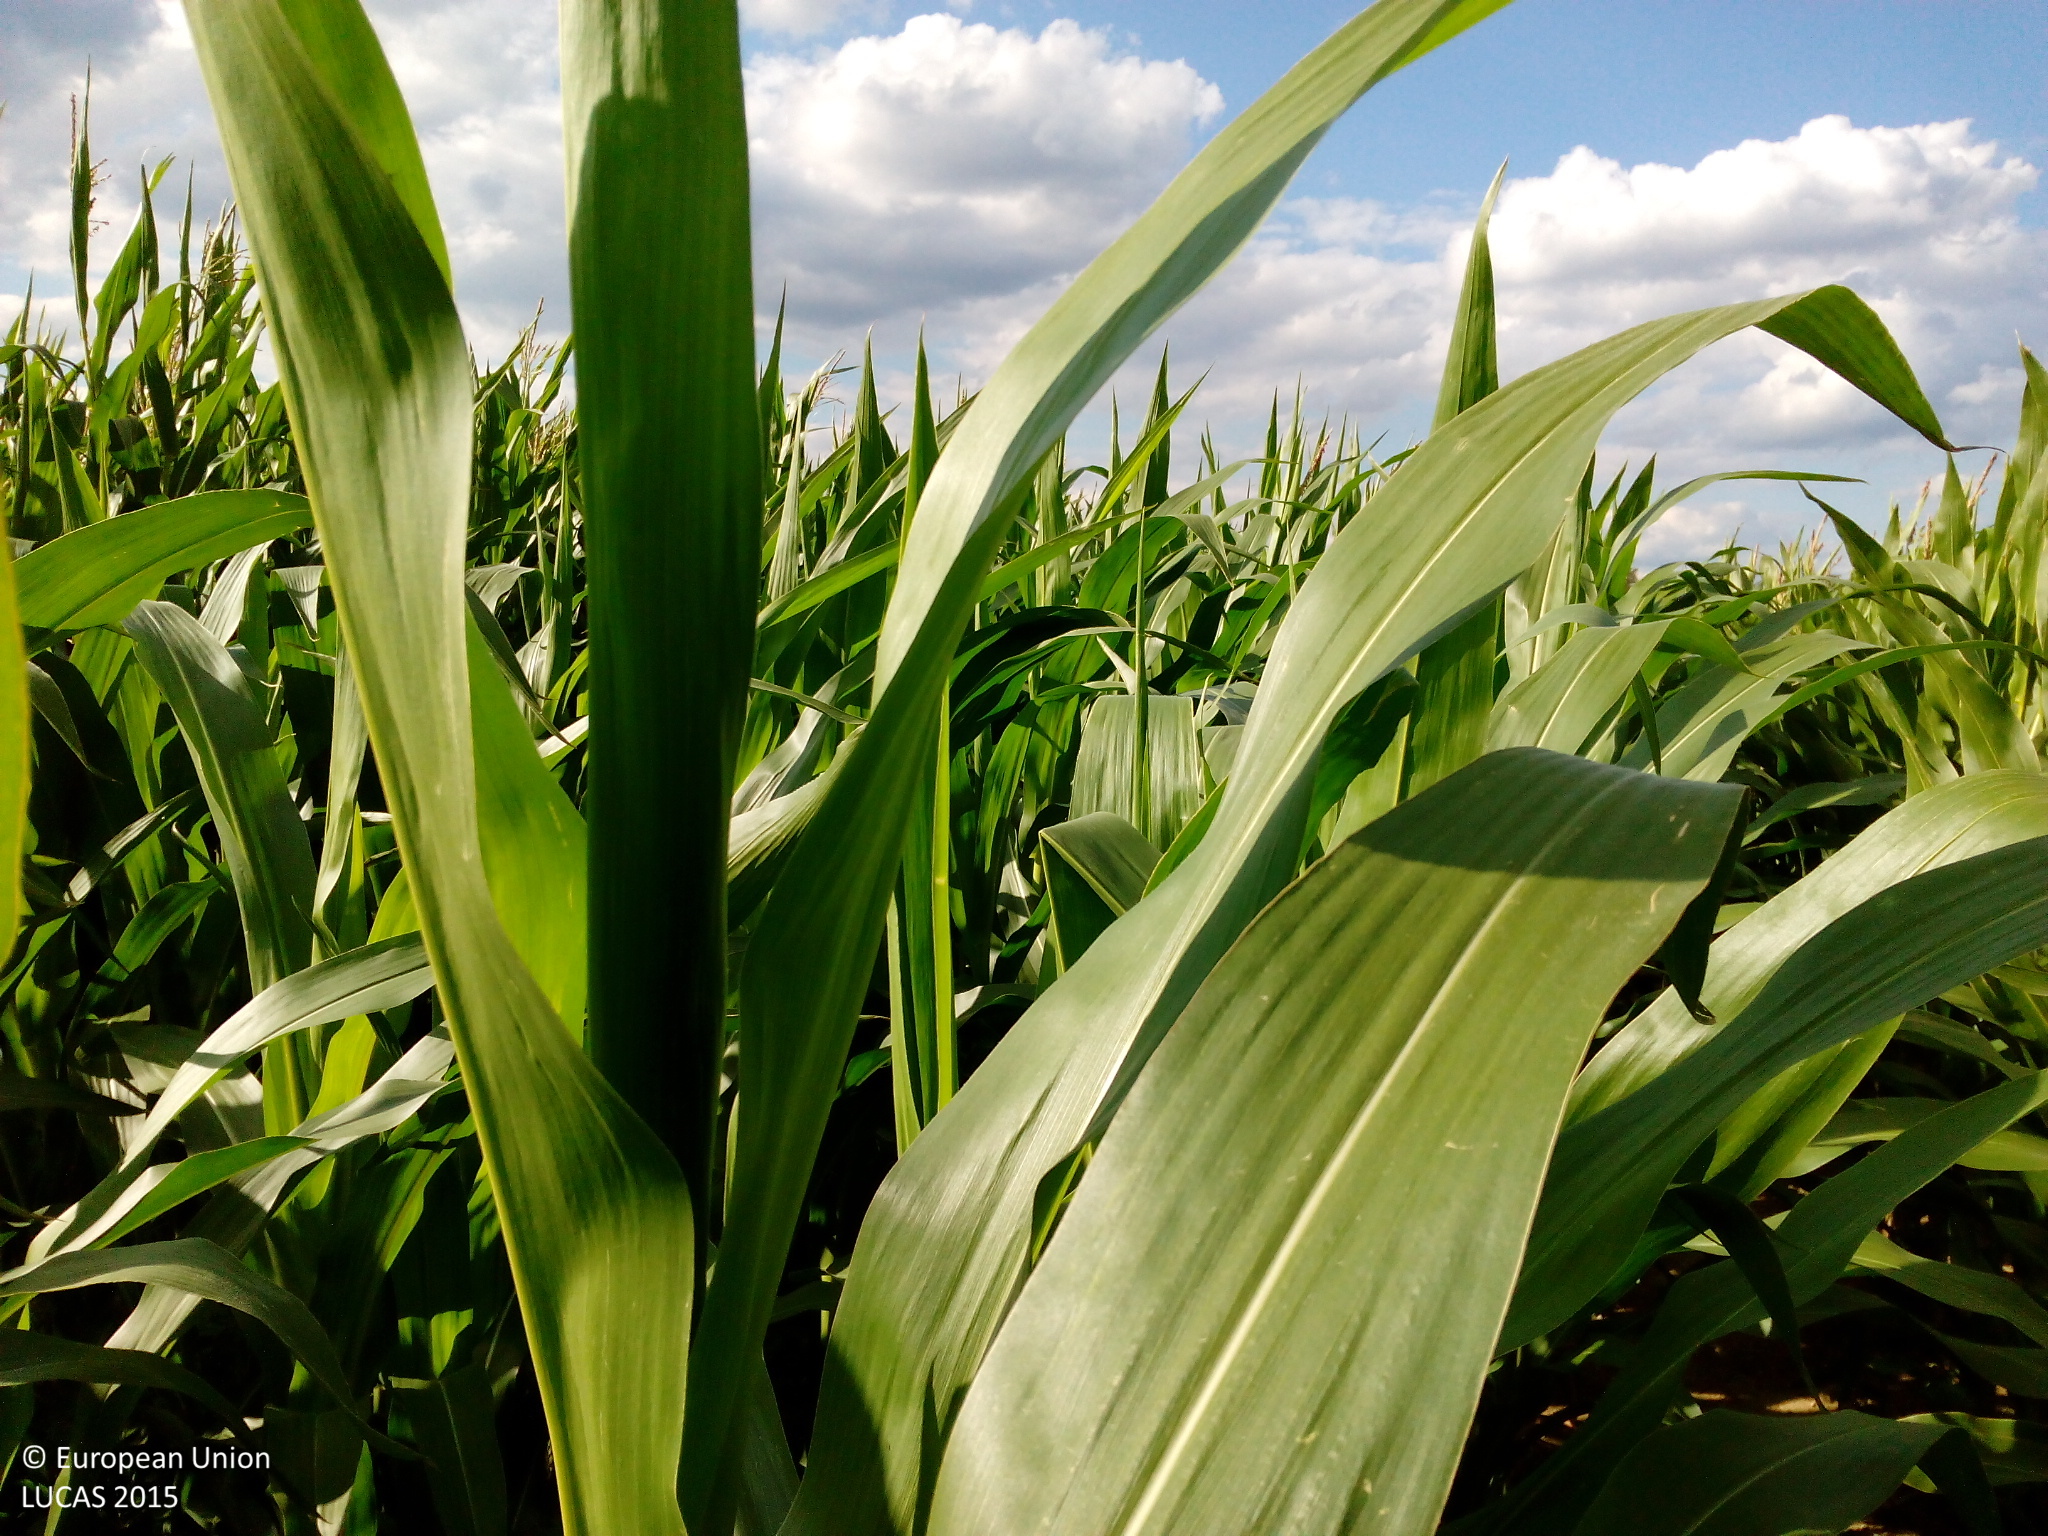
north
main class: Cropland
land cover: Maize
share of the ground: > 75 %
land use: Agriculture (excluding fallow land and kitchen gardens)
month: July
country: DE
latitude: 49.8716
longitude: 12.3789
